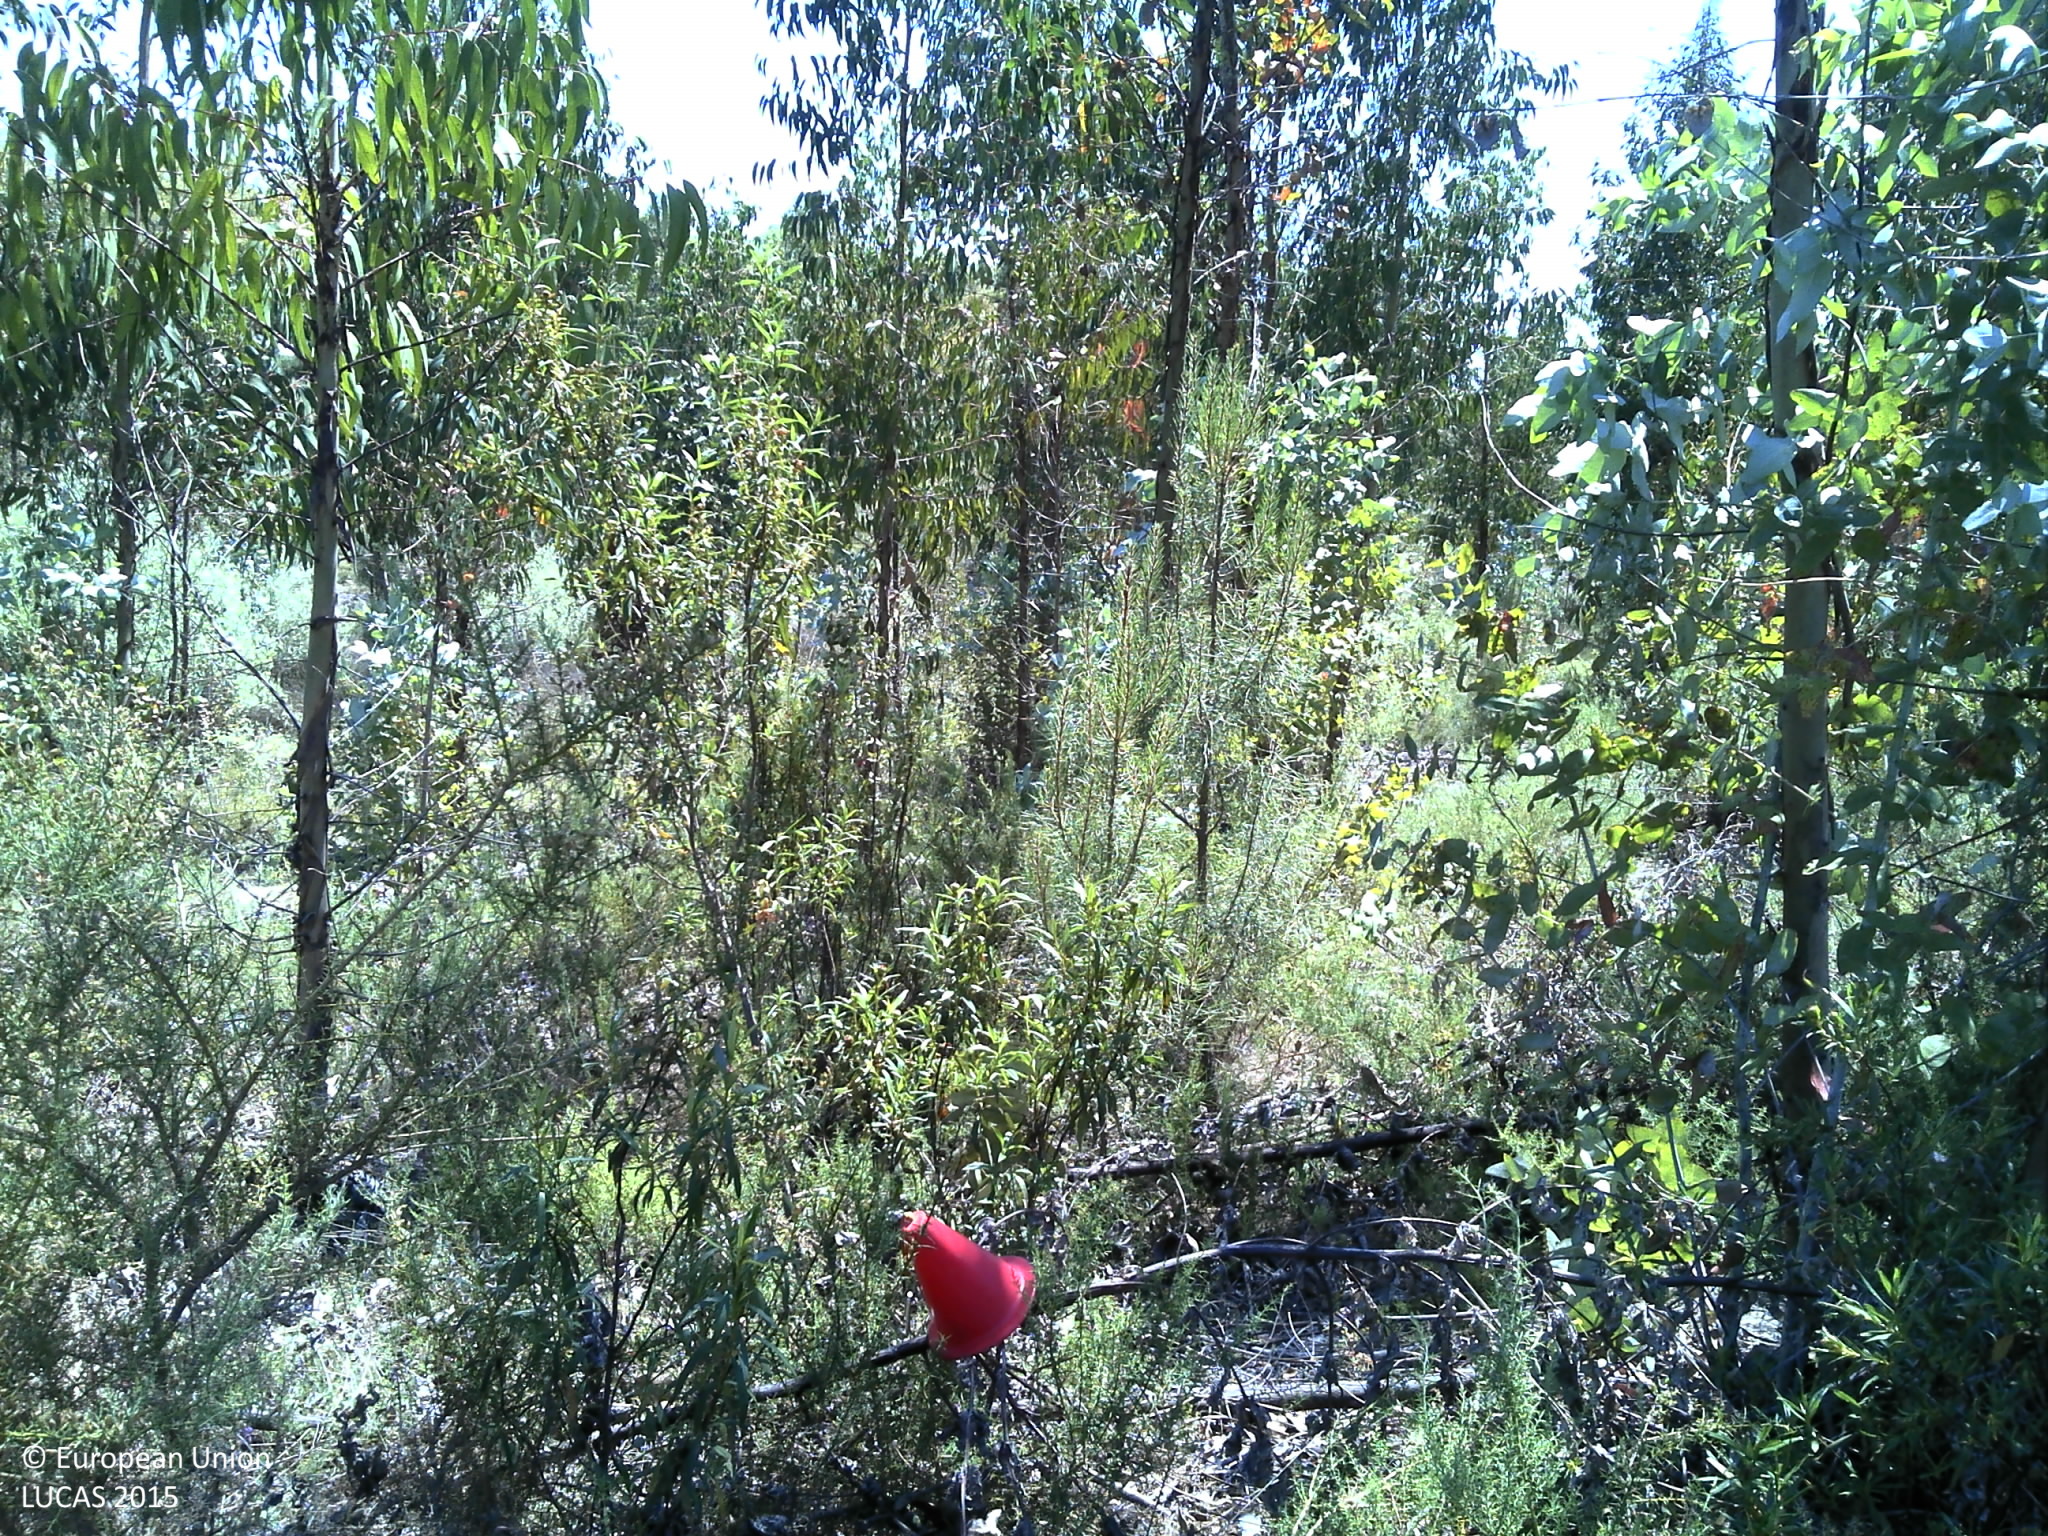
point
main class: Woodland
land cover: Broadleaved woodland
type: exotic forest
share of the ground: 25 - 50 %
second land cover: Shrubland without tree cover
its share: 50 - 75 %
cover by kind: broadleaved forest trees 50 %, shrubs 50 %
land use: Forestry
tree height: > 5 m
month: May
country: PT
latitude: 39.2074
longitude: -7.9444
